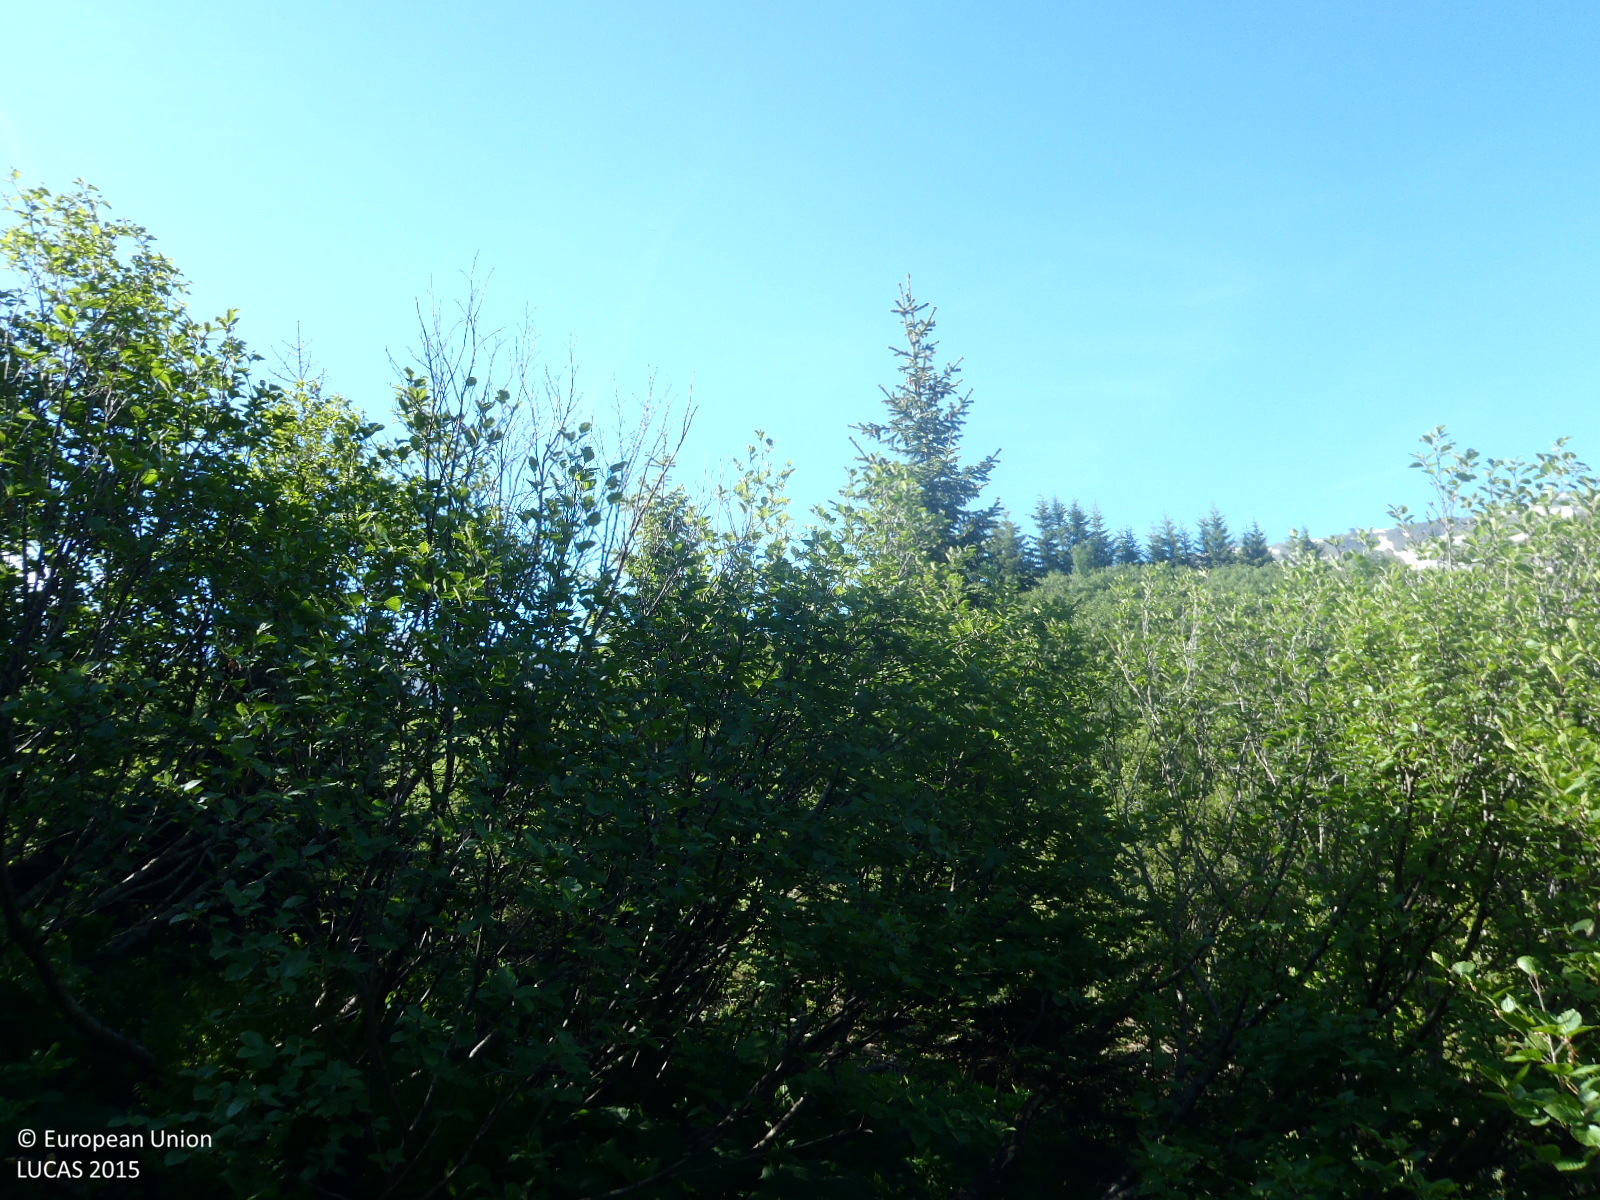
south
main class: Shrubland
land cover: Shrubland with sparse tree cover
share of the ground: > 75 %
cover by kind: shrubs 95 %, coniferous forest trees 5 %
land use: Agriculture (excluding fallow land and kitchen gardens)
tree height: > 5 m
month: June
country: AT
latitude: 47.1434
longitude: 10.1713
